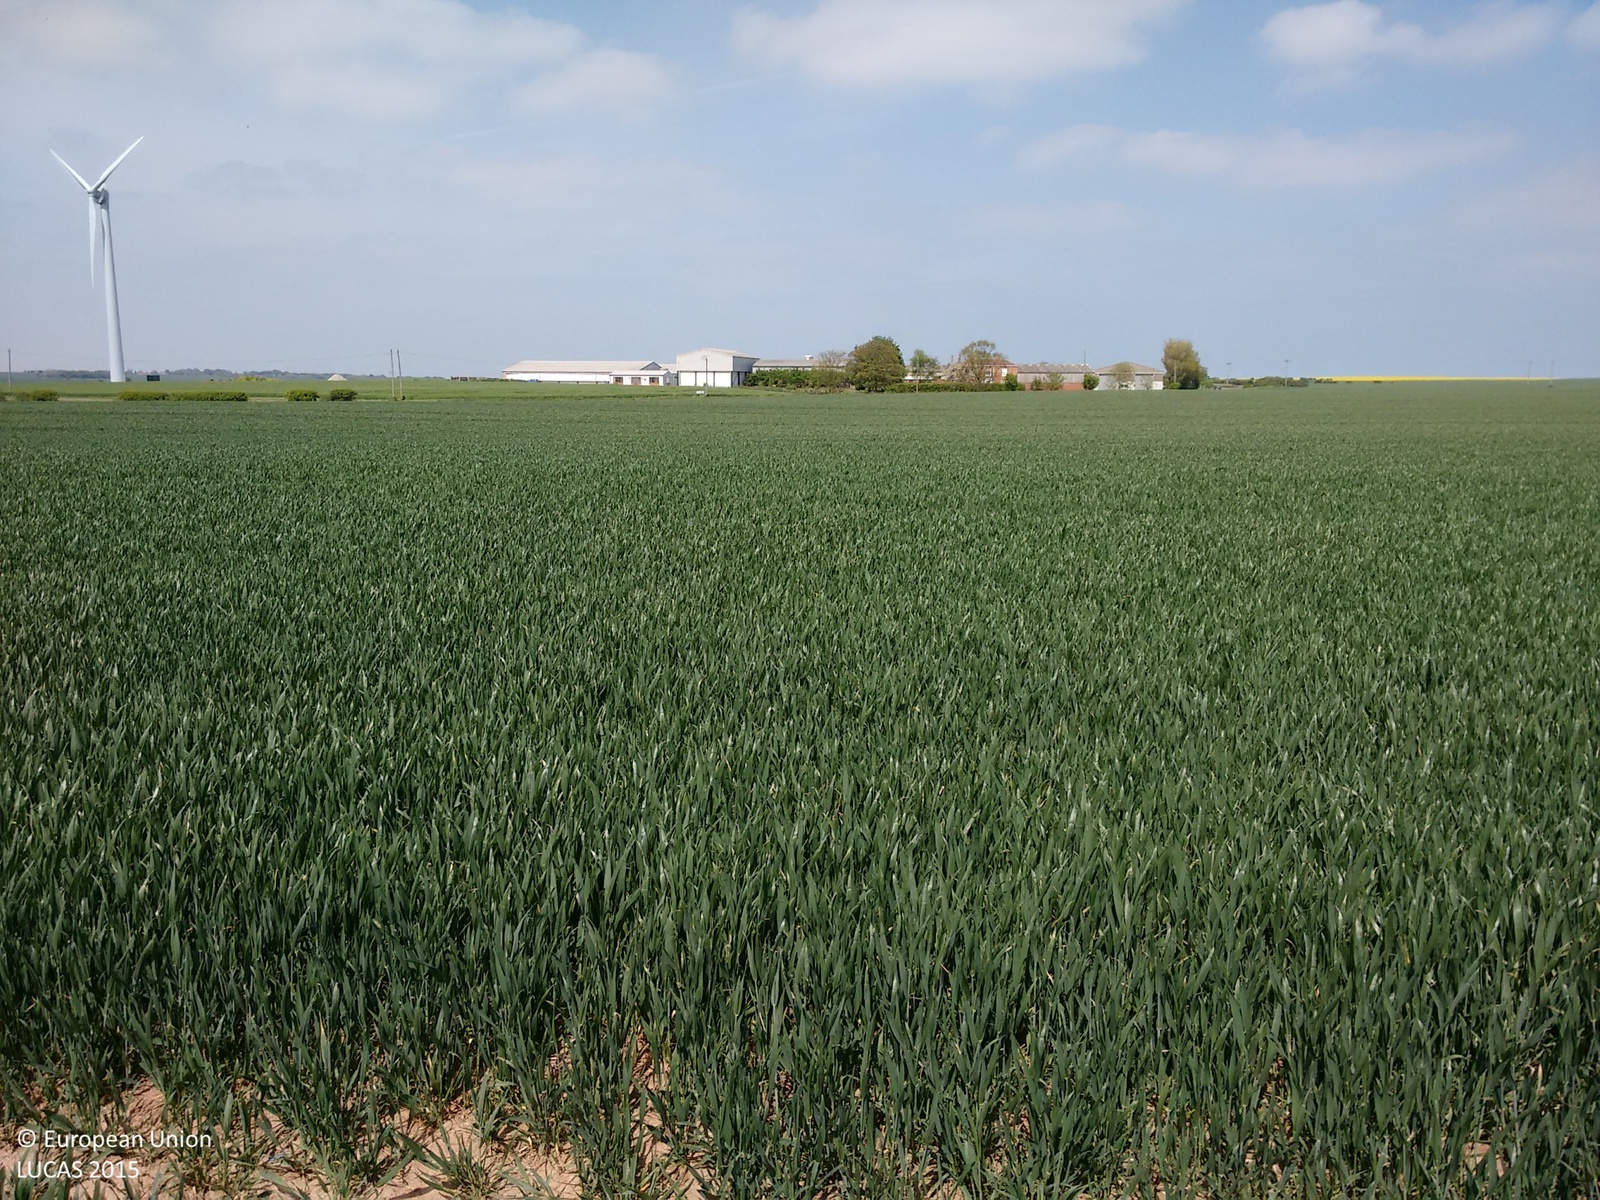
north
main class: Cropland
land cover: Common wheat
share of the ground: > 75 %
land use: Agriculture (excluding fallow land and kitchen gardens)
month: May
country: GB
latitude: 53.6646
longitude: 0.0868
